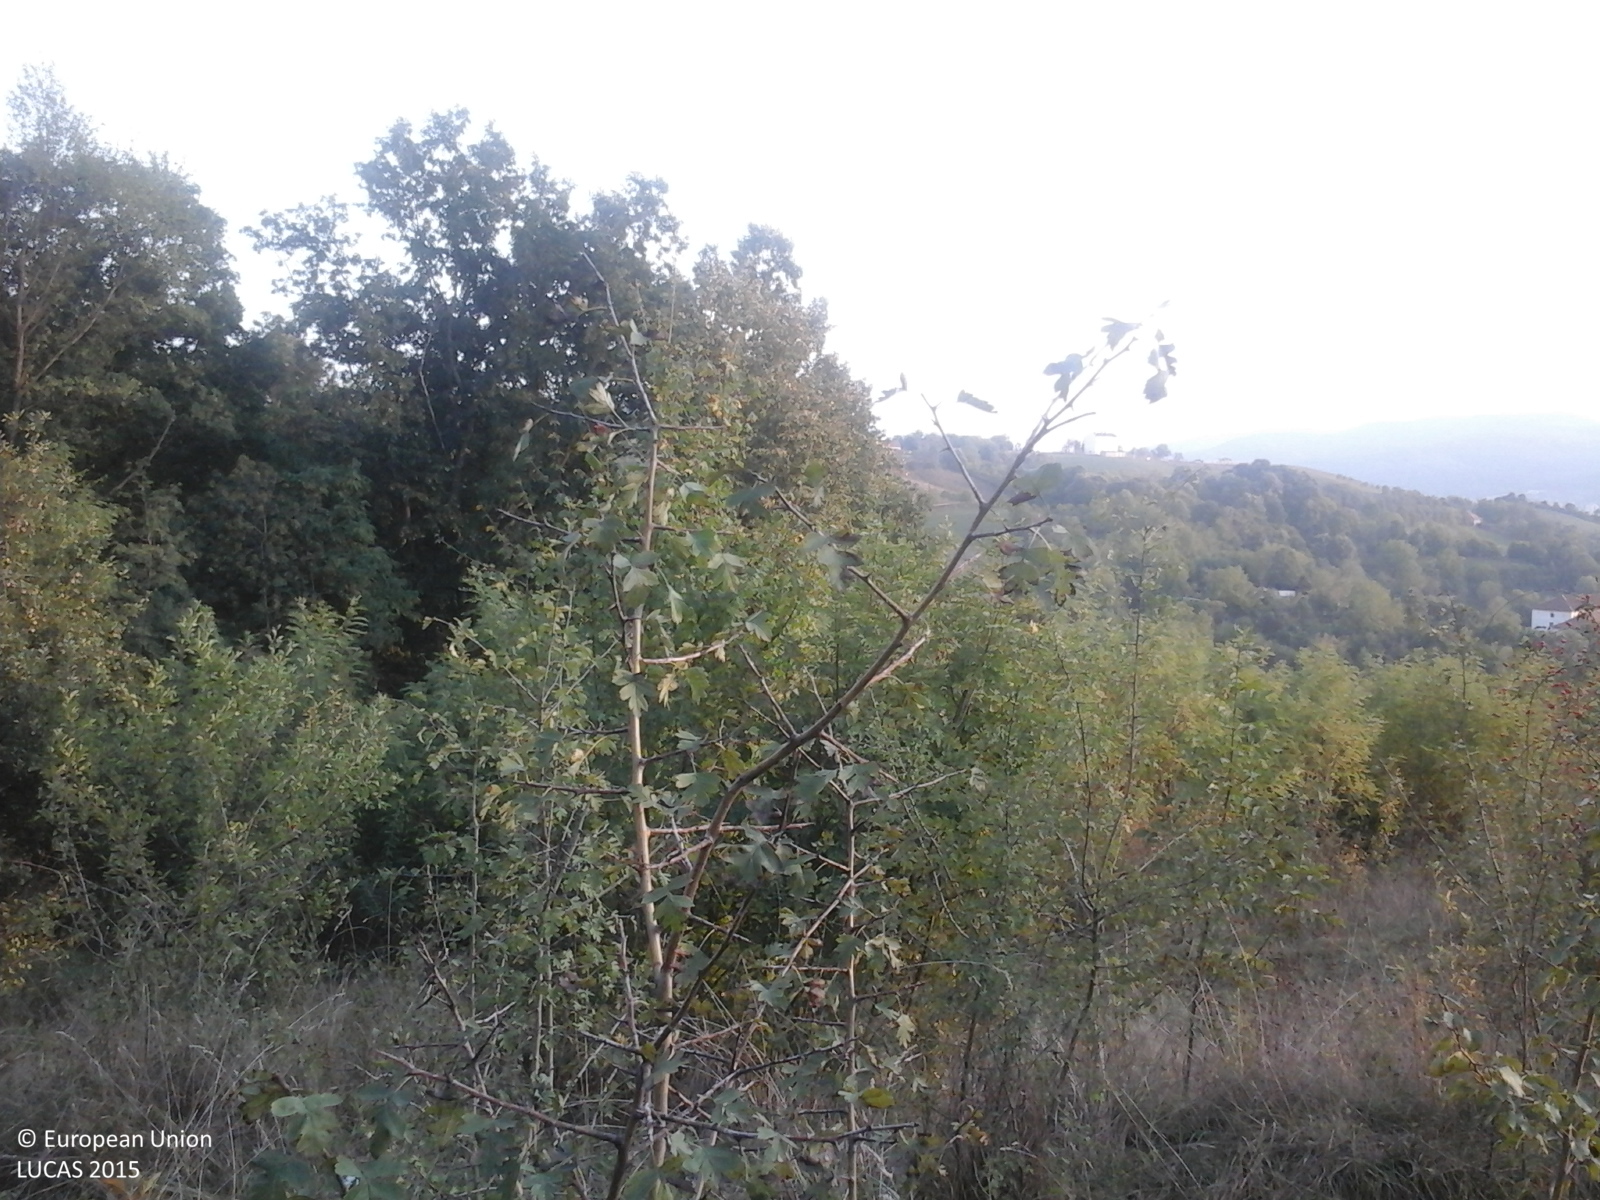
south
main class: Cropland
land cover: Other fruit trees and berries
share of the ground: 50 - 75 %
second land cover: Spontaneously vegetated surfaces
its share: > 75 %
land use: Agriculture (excluding fallow land and kitchen gardens)
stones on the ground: 10 - 25 %
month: September
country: RO
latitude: 45.3216
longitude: 21.8876
